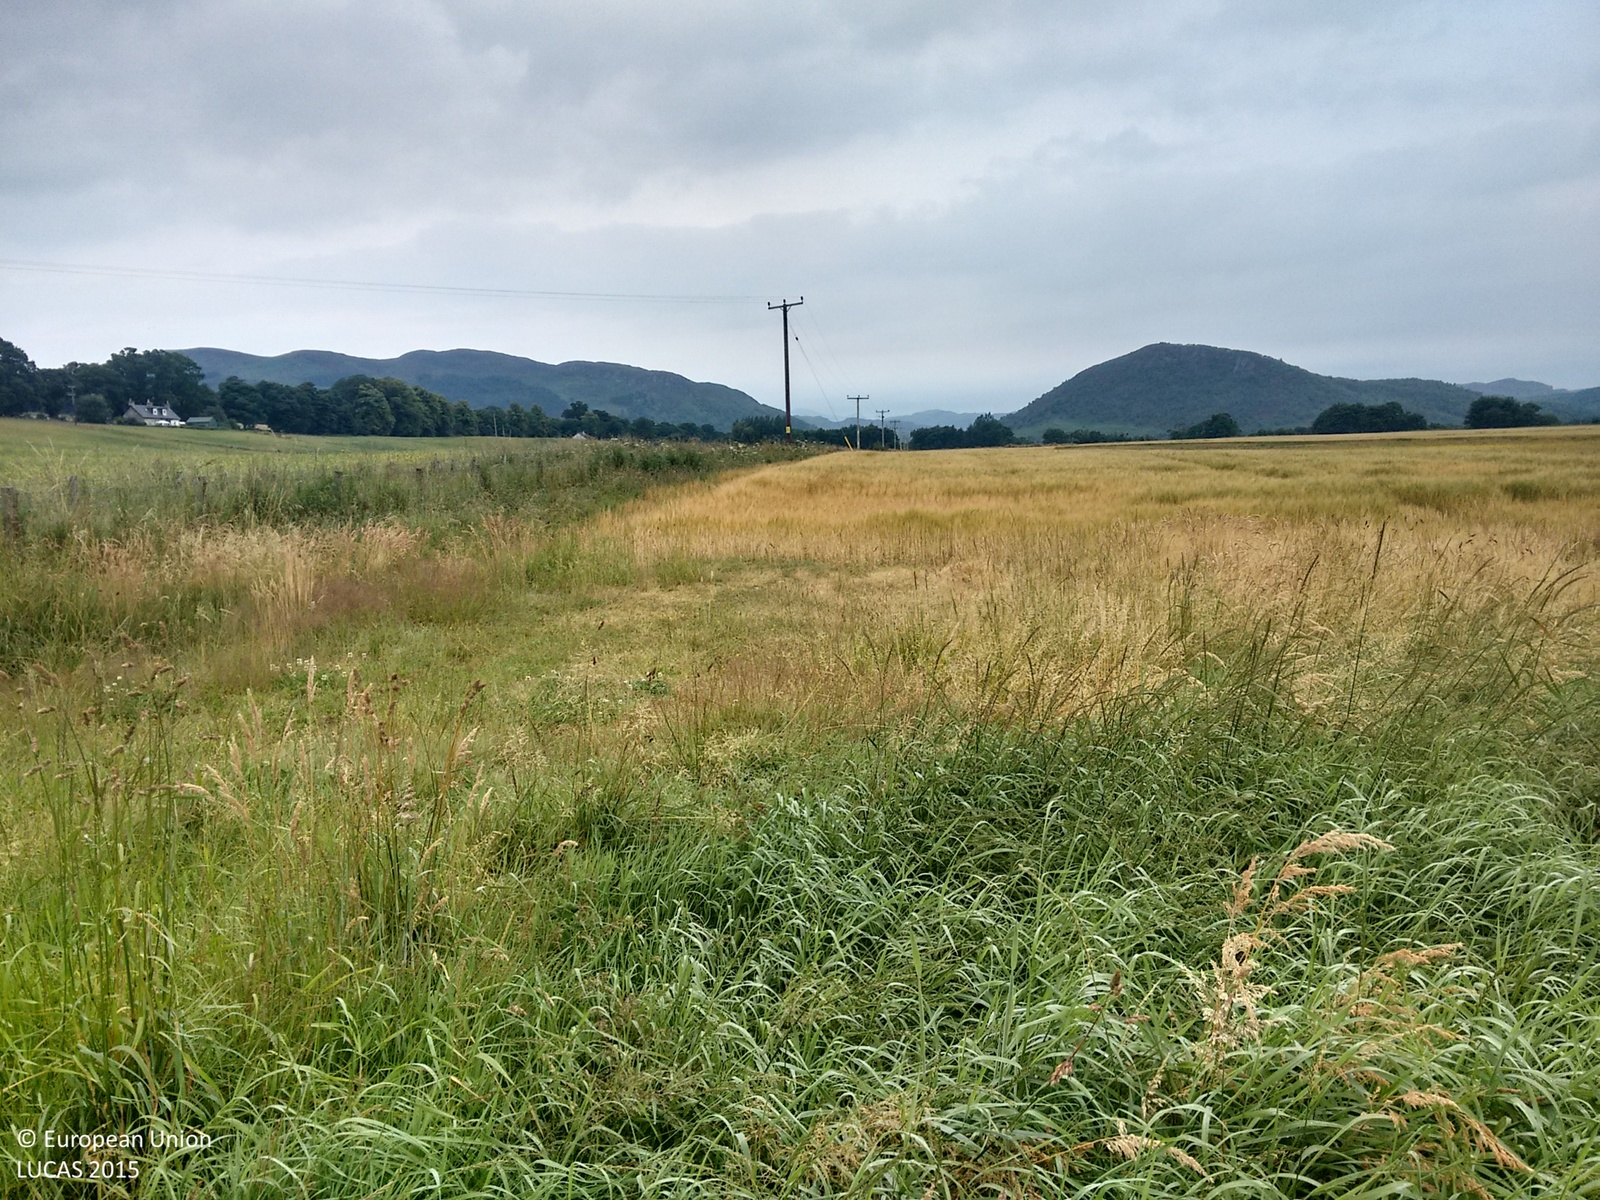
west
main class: Grassland
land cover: Grassland without tree/shrub cover
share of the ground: > 75 %
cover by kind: herbaceous plants 100 %
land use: Agriculture (excluding fallow land and kitchen gardens)
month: August
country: GB
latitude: 57.5502
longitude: -4.5461
